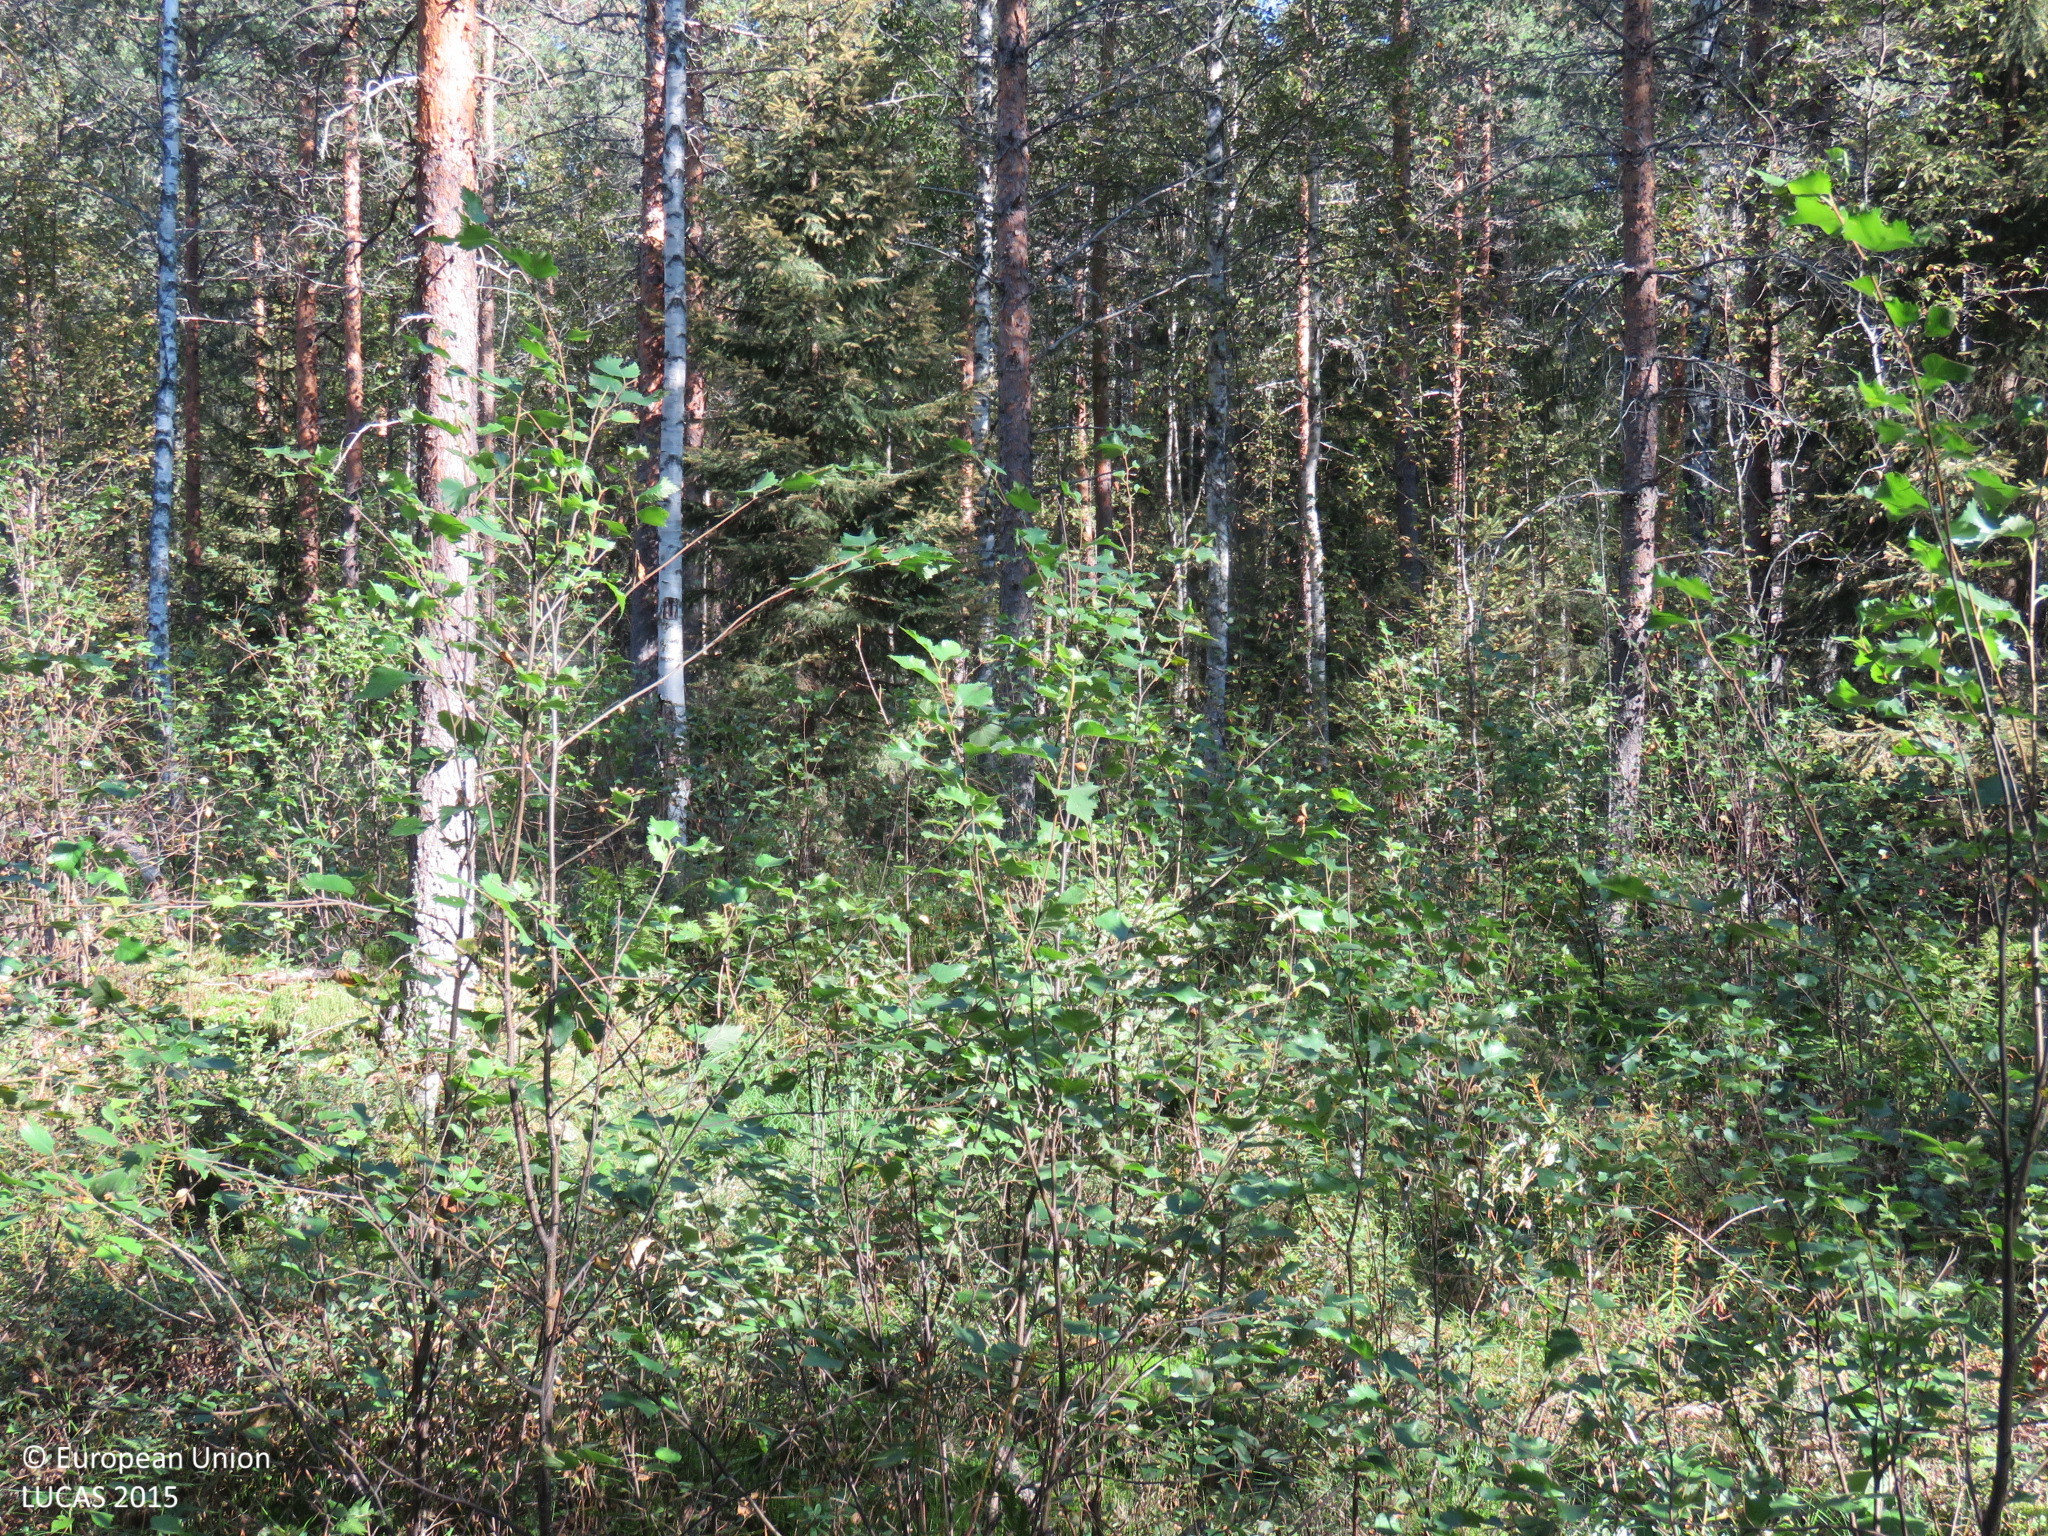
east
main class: Woodland
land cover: Pine dominated mixed woodland
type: mire and swamp forests
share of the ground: > 75 %
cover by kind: coniferous forest trees 60 %, broadleaved forest trees 25 %, shrubs 10 %, herbaceous plants 5 %
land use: Forestry
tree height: > 5 m
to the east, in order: Pine dominated mixed woodland; Ditches and canals; Other mixed woodland; Ditches and canals; Other mixed woodland; Other coniferous woodland; Pine dominated coniferous woodland; Ditches and canals; Other coniferous woodland
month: August
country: FI
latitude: 64.9998
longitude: 25.6745
